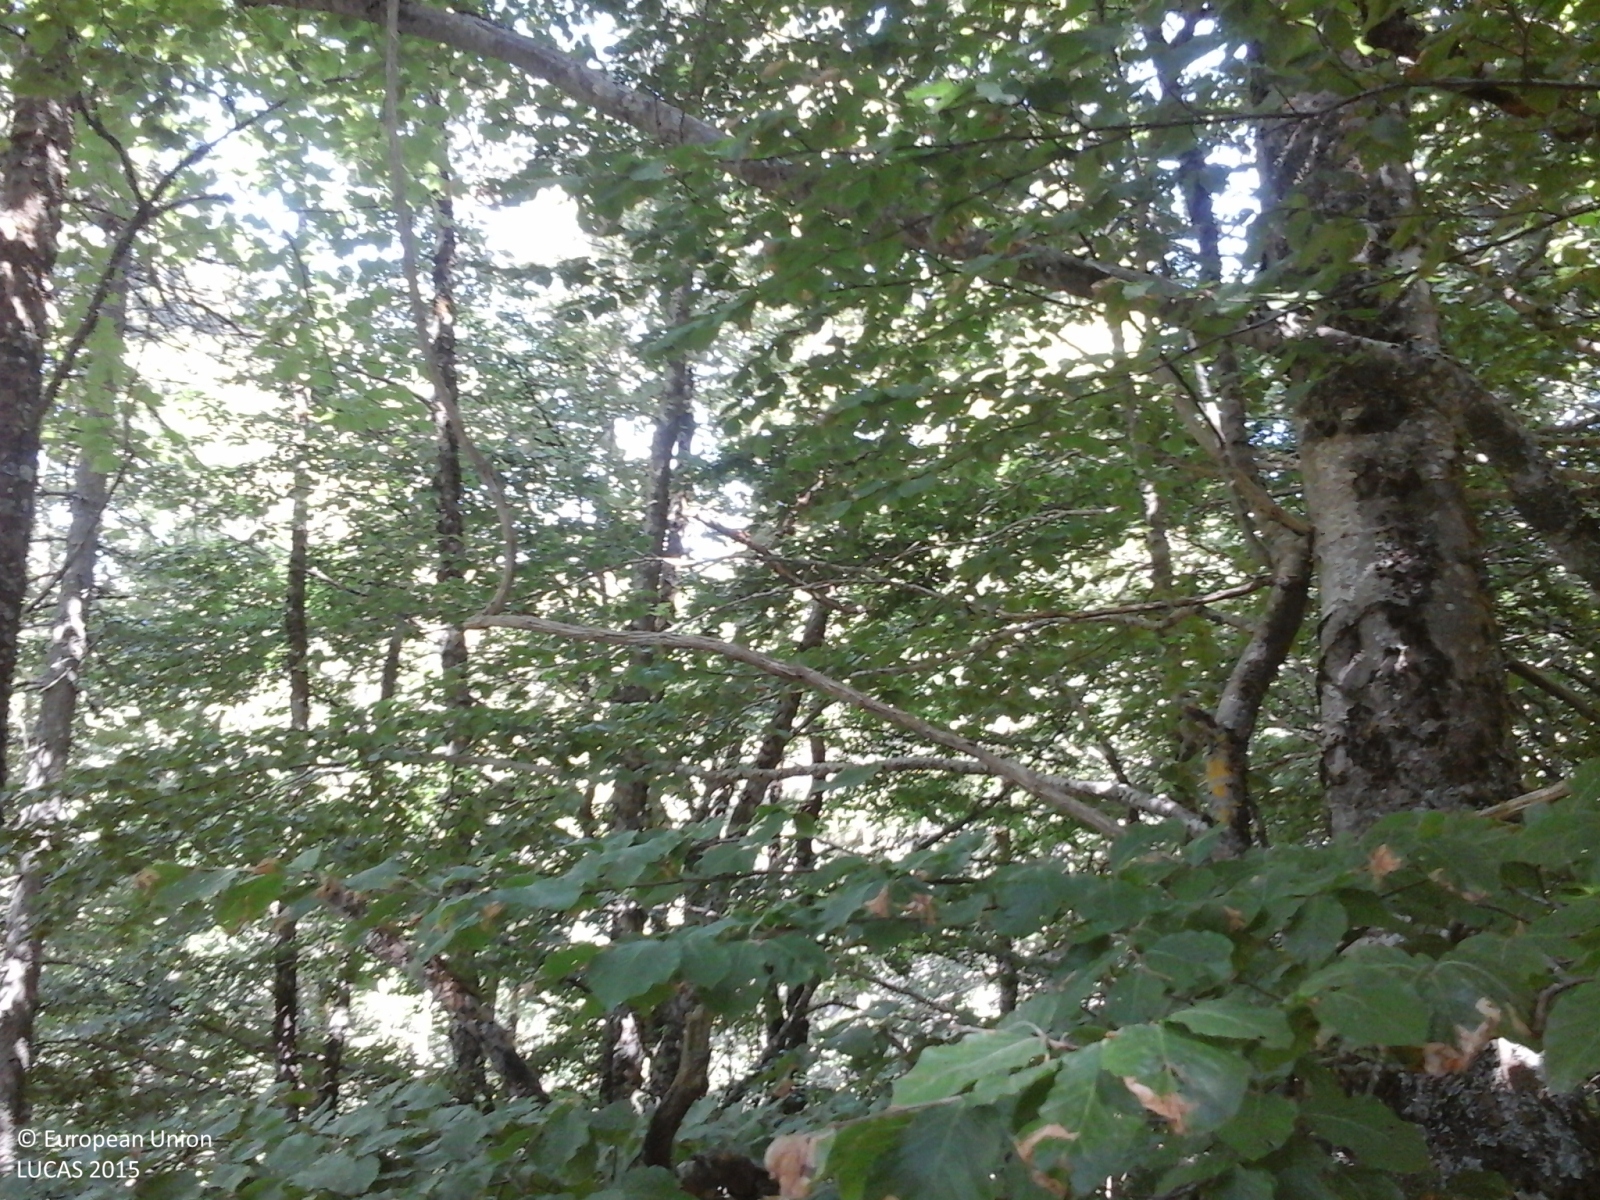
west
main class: Woodland
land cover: Other mixed woodland
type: mountainous beech forest
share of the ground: > 75 %
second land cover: Grassland without tree/shrub cover
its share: > 75 %
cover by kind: coniferous forest trees 40 %, broadleaved forest trees 35 %, herbaceous plants 15 %, shrubs 10 %
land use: Forestry
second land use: Agriculture (excluding fallow land and kitchen gardens)
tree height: > 5 m
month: July
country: IT
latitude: 40.8216
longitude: 15.1374
